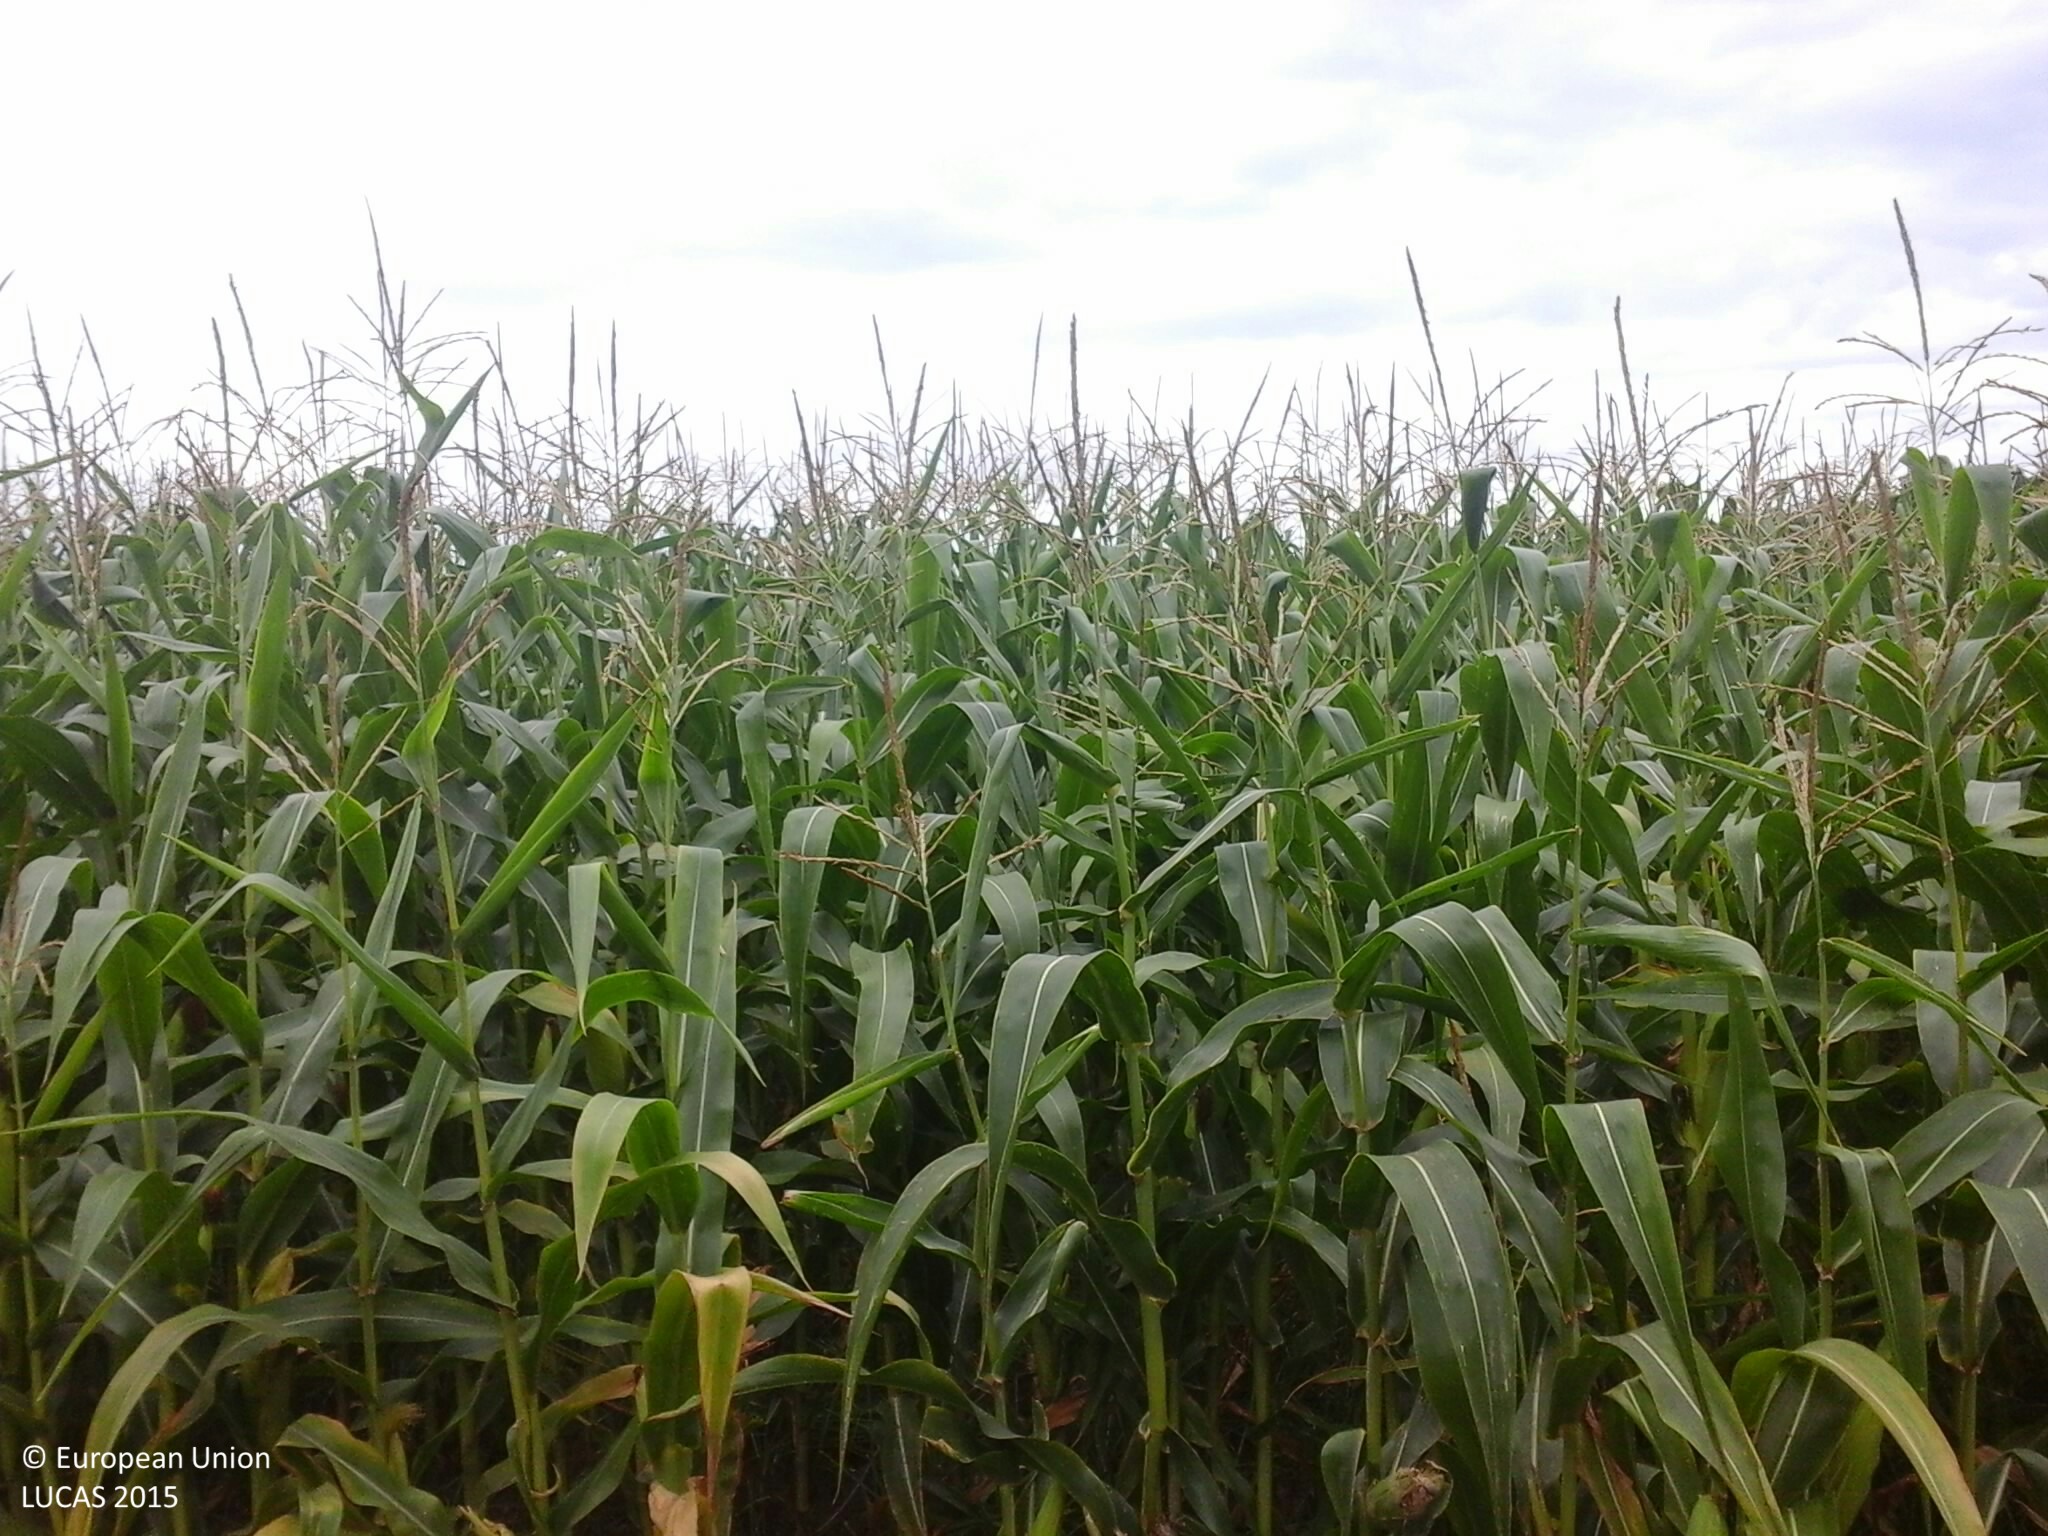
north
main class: Cropland
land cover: Maize
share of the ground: > 75 %
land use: Agriculture (excluding fallow land and kitchen gardens)
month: July
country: HU
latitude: 46.6841
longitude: 17.7599
